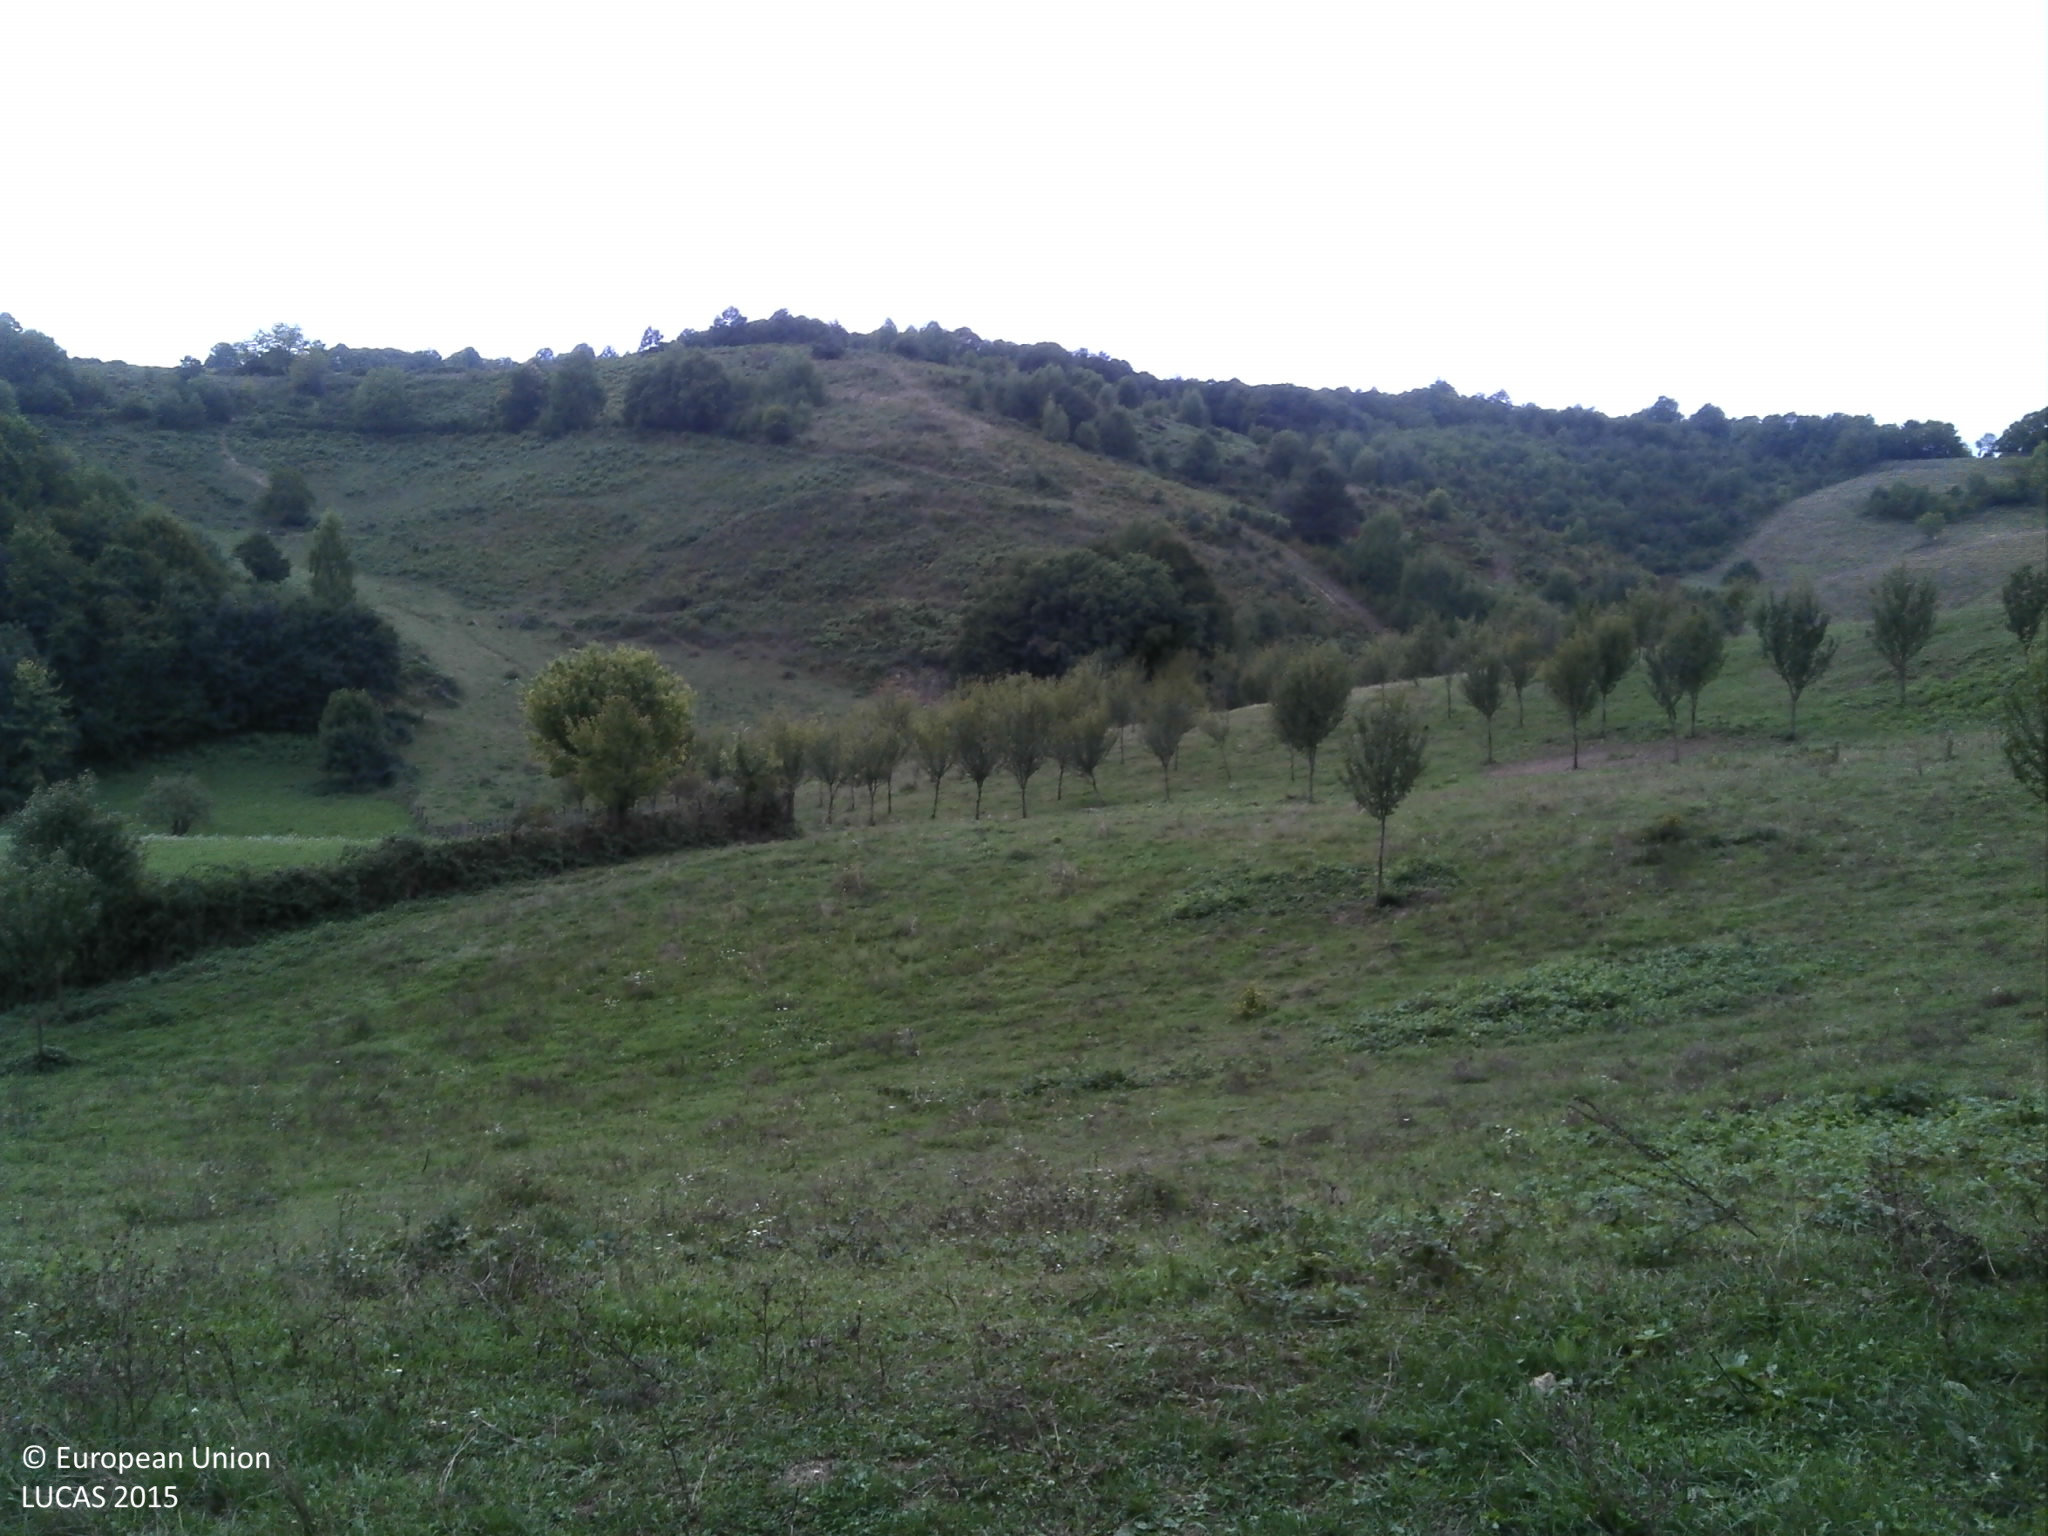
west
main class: Grassland
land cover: Grassland with sparse tree/shrub cover
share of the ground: > 75 %
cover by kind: herbaceous plants 95 %, broadleaved forest trees 5 %
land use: Agriculture (excluding fallow land and kitchen gardens)
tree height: < 5 m
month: September
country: HR
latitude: 45.1721
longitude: 15.6577
